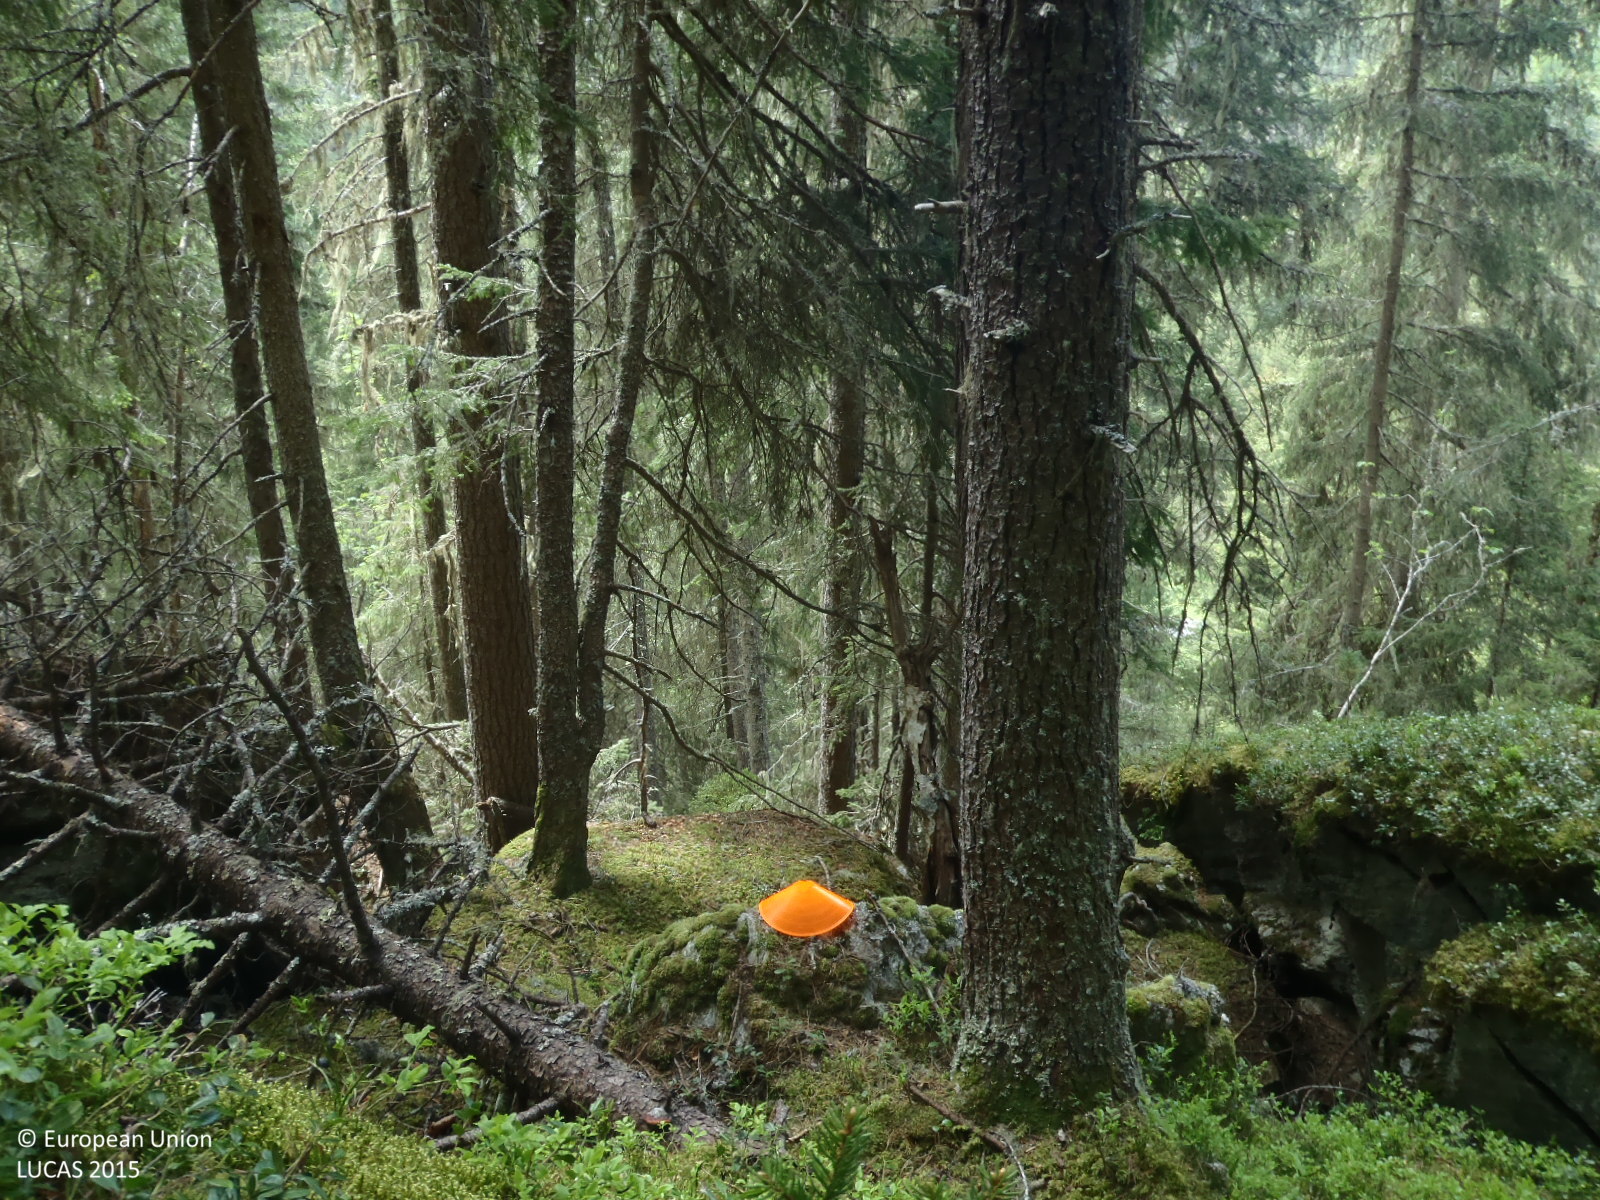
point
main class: Woodland
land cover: Spruce dominated coniferous woodland
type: alpine coniferous forest
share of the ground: > 75 %
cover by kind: coniferous forest trees 85 %, shrubs 5 %, herbaceous plants 5 %, lichens and mosses 5 %
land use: Forestry
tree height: > 5 m
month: June
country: AT
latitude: 47.2293
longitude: 10.9632
